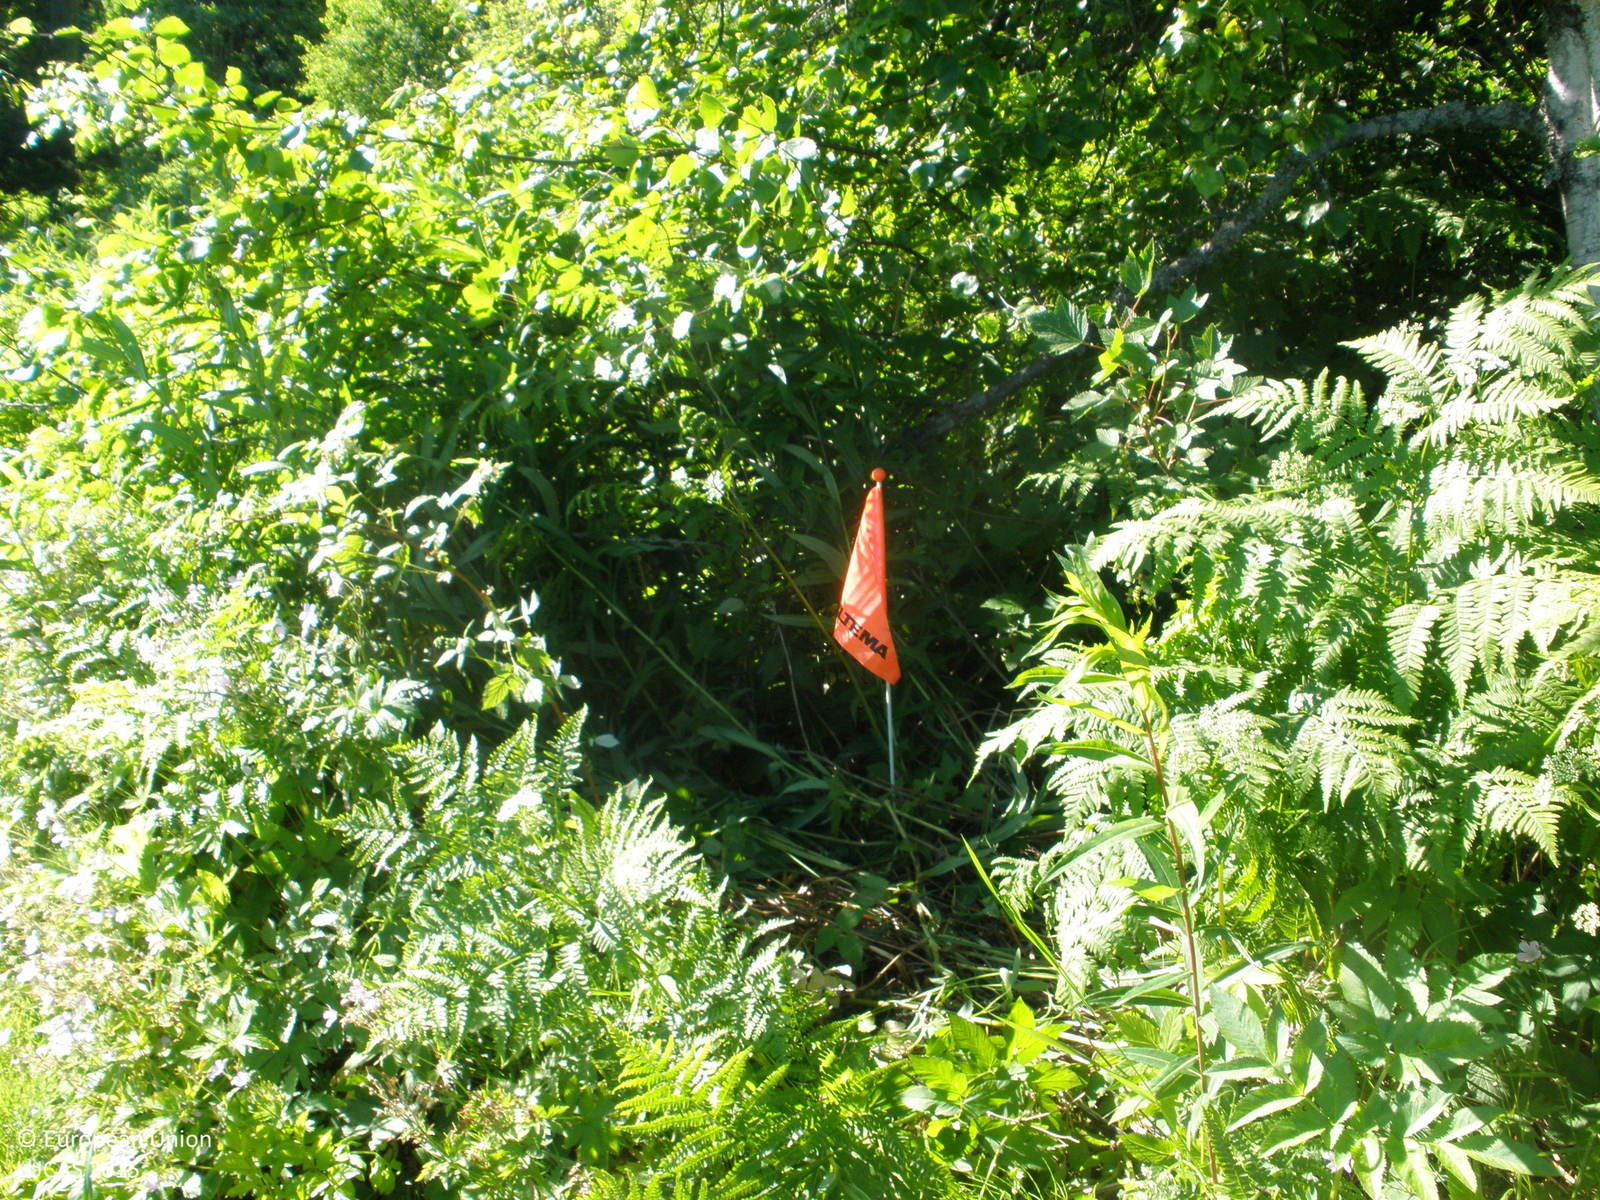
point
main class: Woodland
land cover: Broadleaved woodland
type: non-riverine alder, birch or aspen forest
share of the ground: > 75 %
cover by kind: broadleaved forest trees 85 %, shrubs 10 %, herbaceous plants 5 %
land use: Forestry
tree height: > 5 m
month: July
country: FI
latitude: 61.2443
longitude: 23.9344
